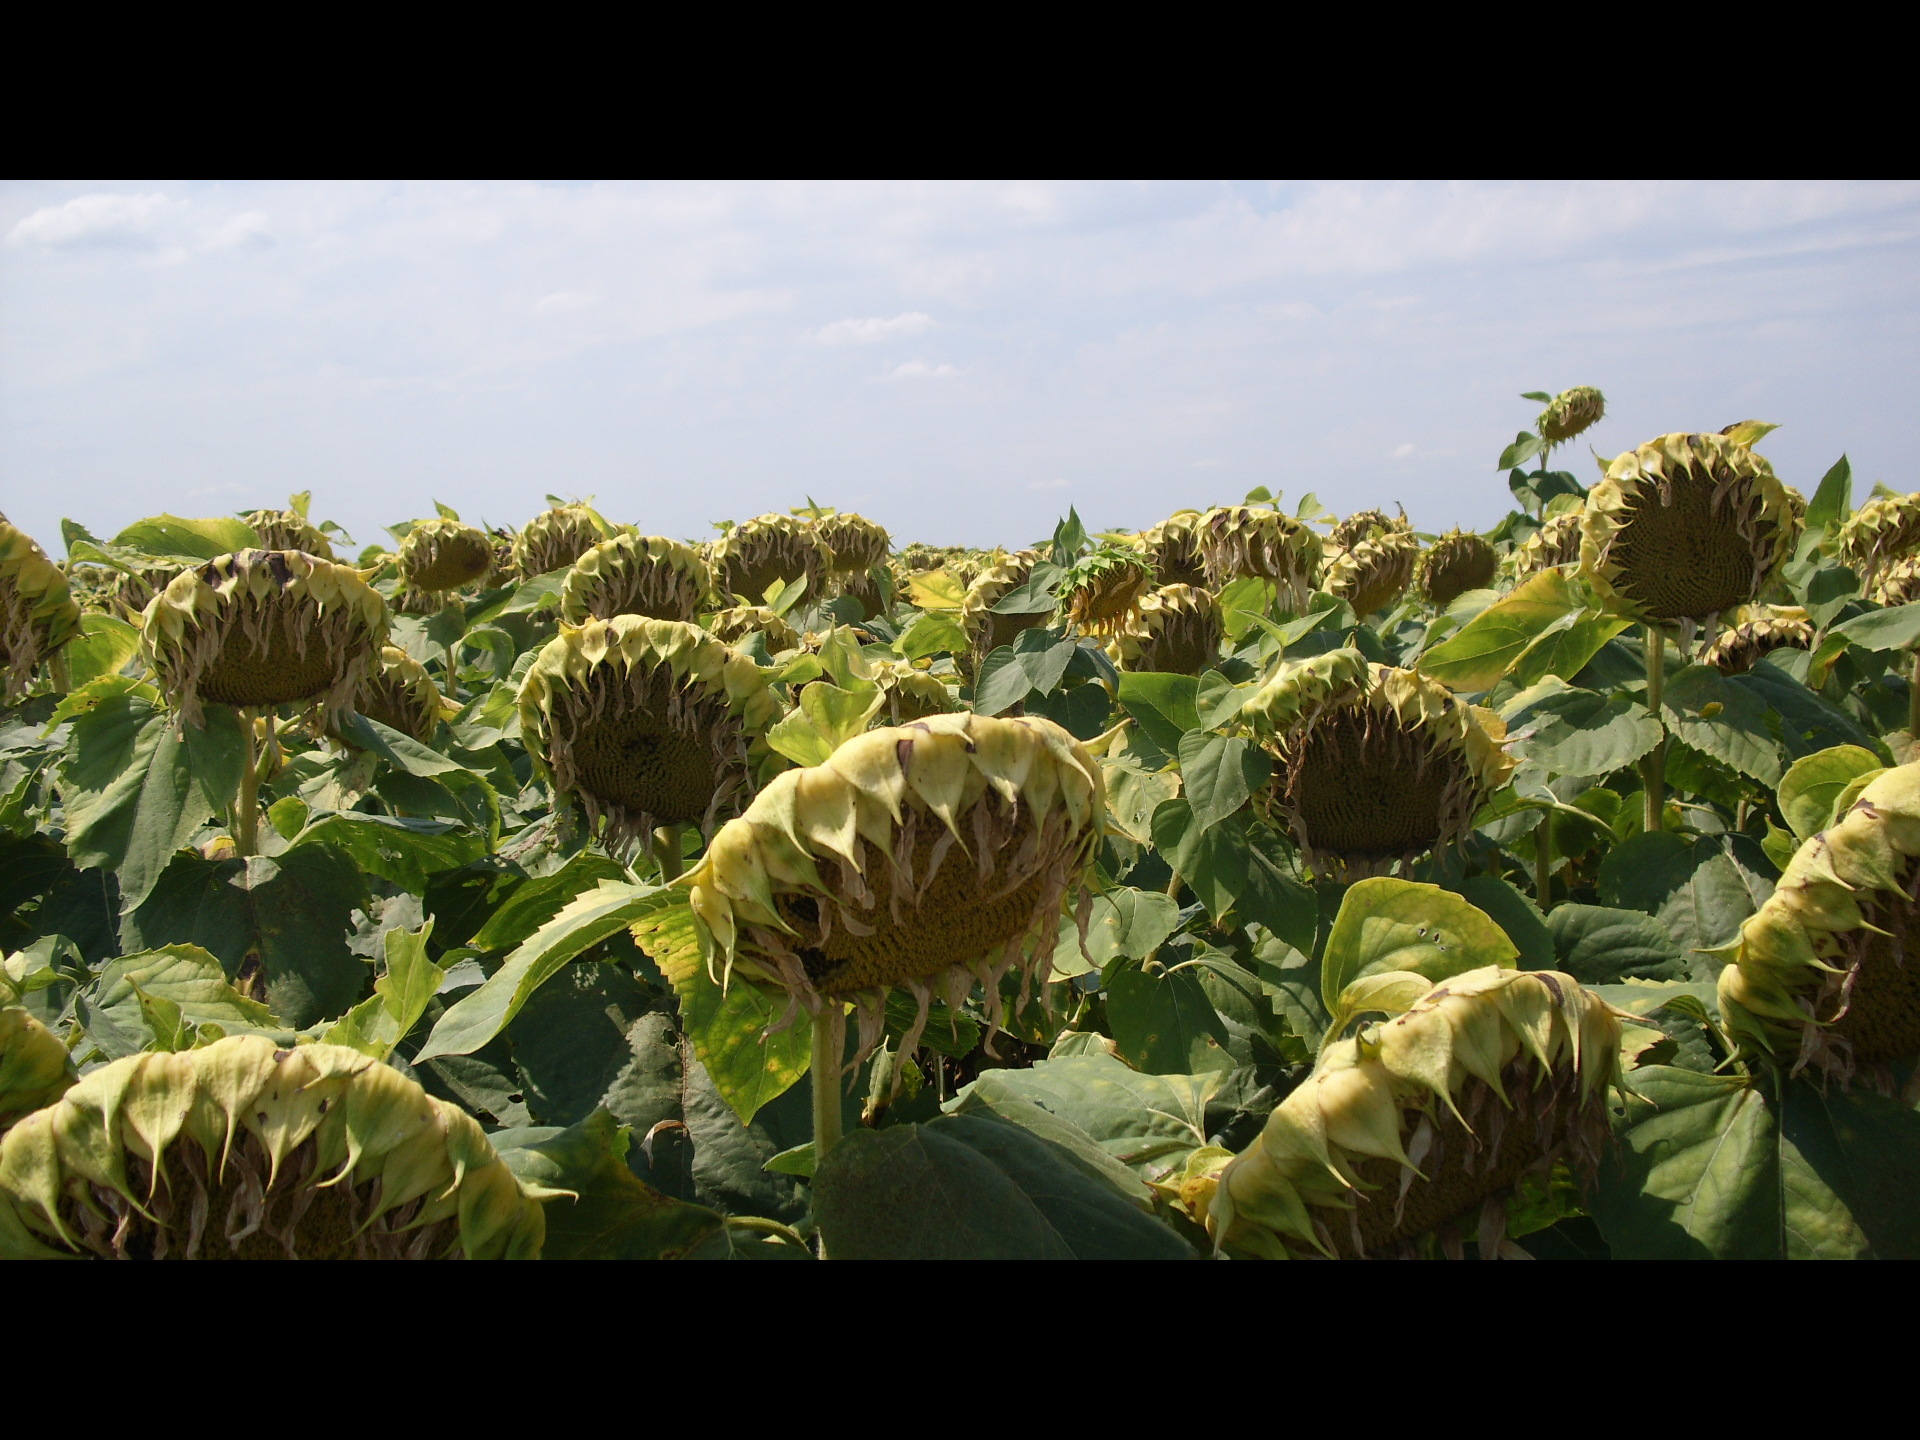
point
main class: Cropland
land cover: Sunflower
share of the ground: > 75 %
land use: Agriculture (excluding fallow land and kitchen gardens)
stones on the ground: < 10 %
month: July
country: BG
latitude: 43.7610
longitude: 23.6000
